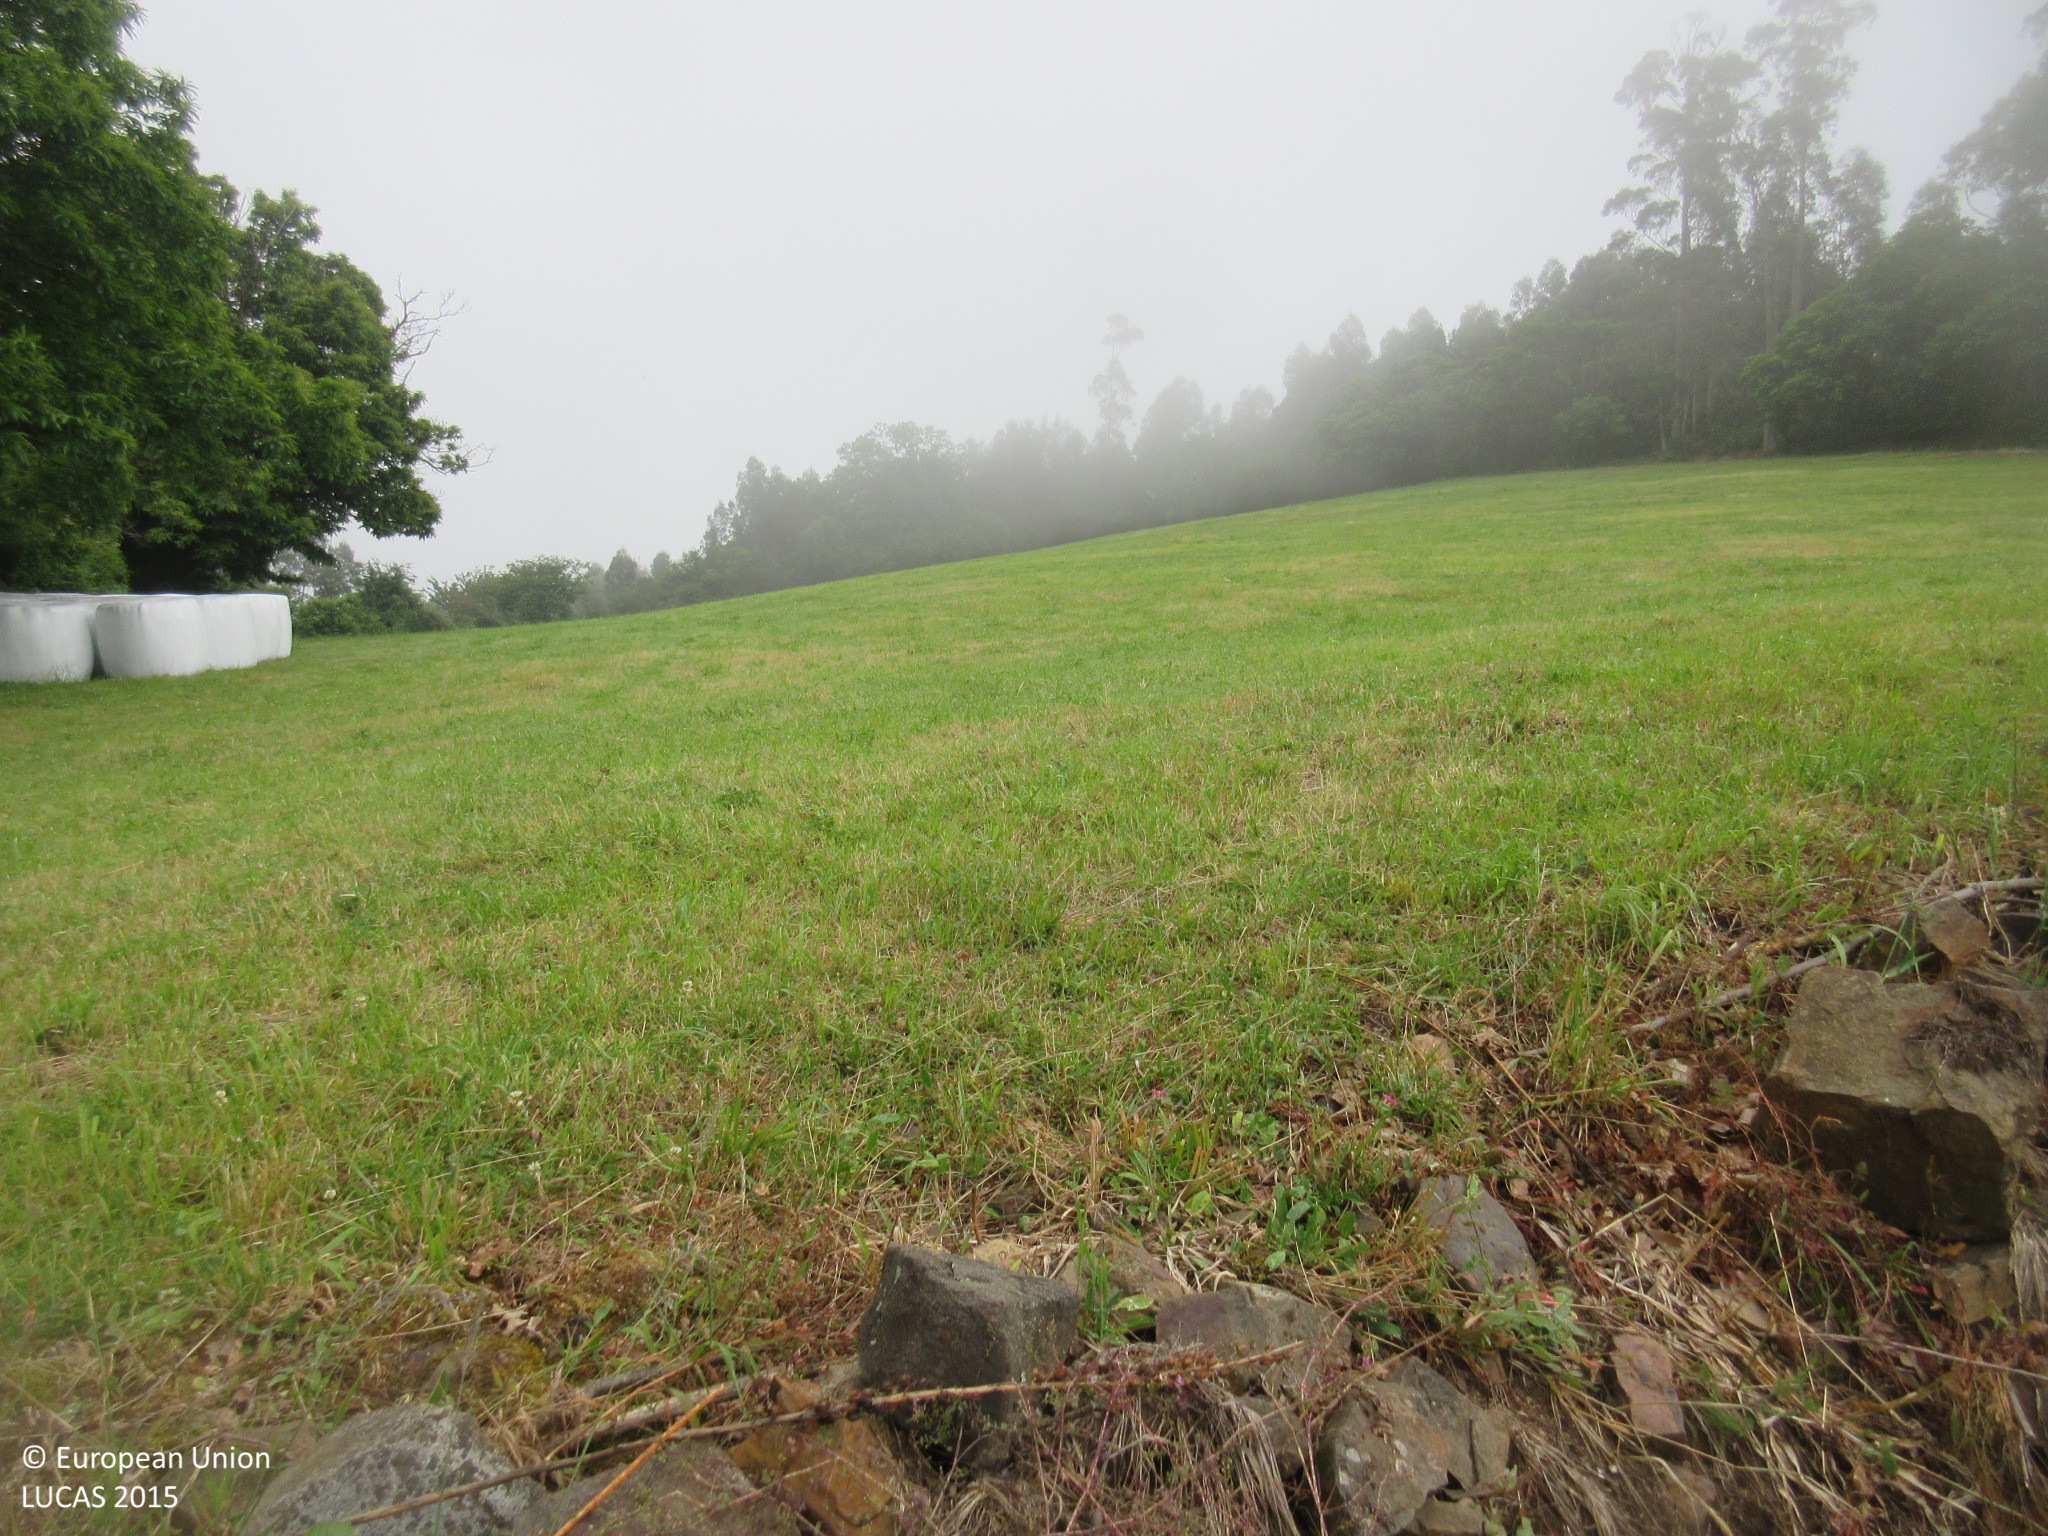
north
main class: Grassland
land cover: Grassland without tree/shrub cover
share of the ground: > 75 %
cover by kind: herbaceous plants 100 %
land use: Agriculture (excluding fallow land and kitchen gardens)
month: June
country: ES
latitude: 43.4237
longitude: -6.0391
